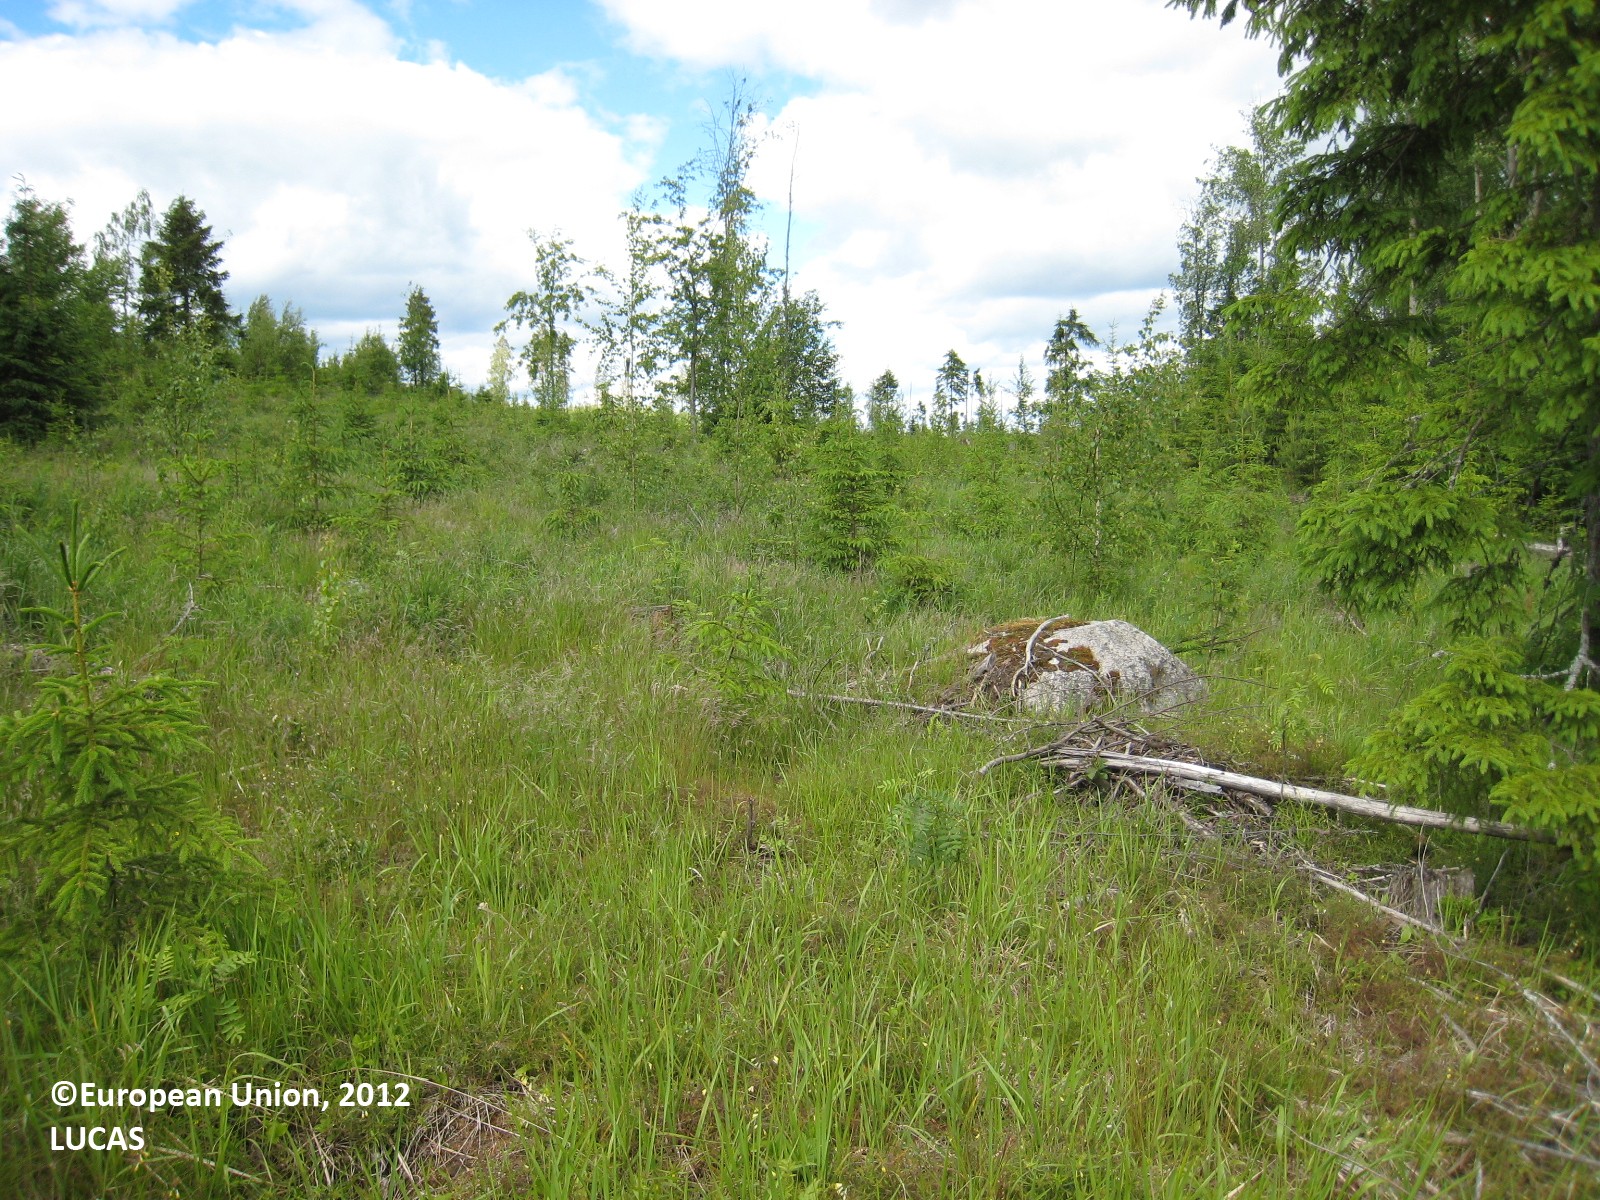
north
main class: Grassland
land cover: Grassland with sparse tree/shrub cover
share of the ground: > 75 %
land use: Forestry
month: June
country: FI
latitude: 62.1434
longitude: 26.2686
